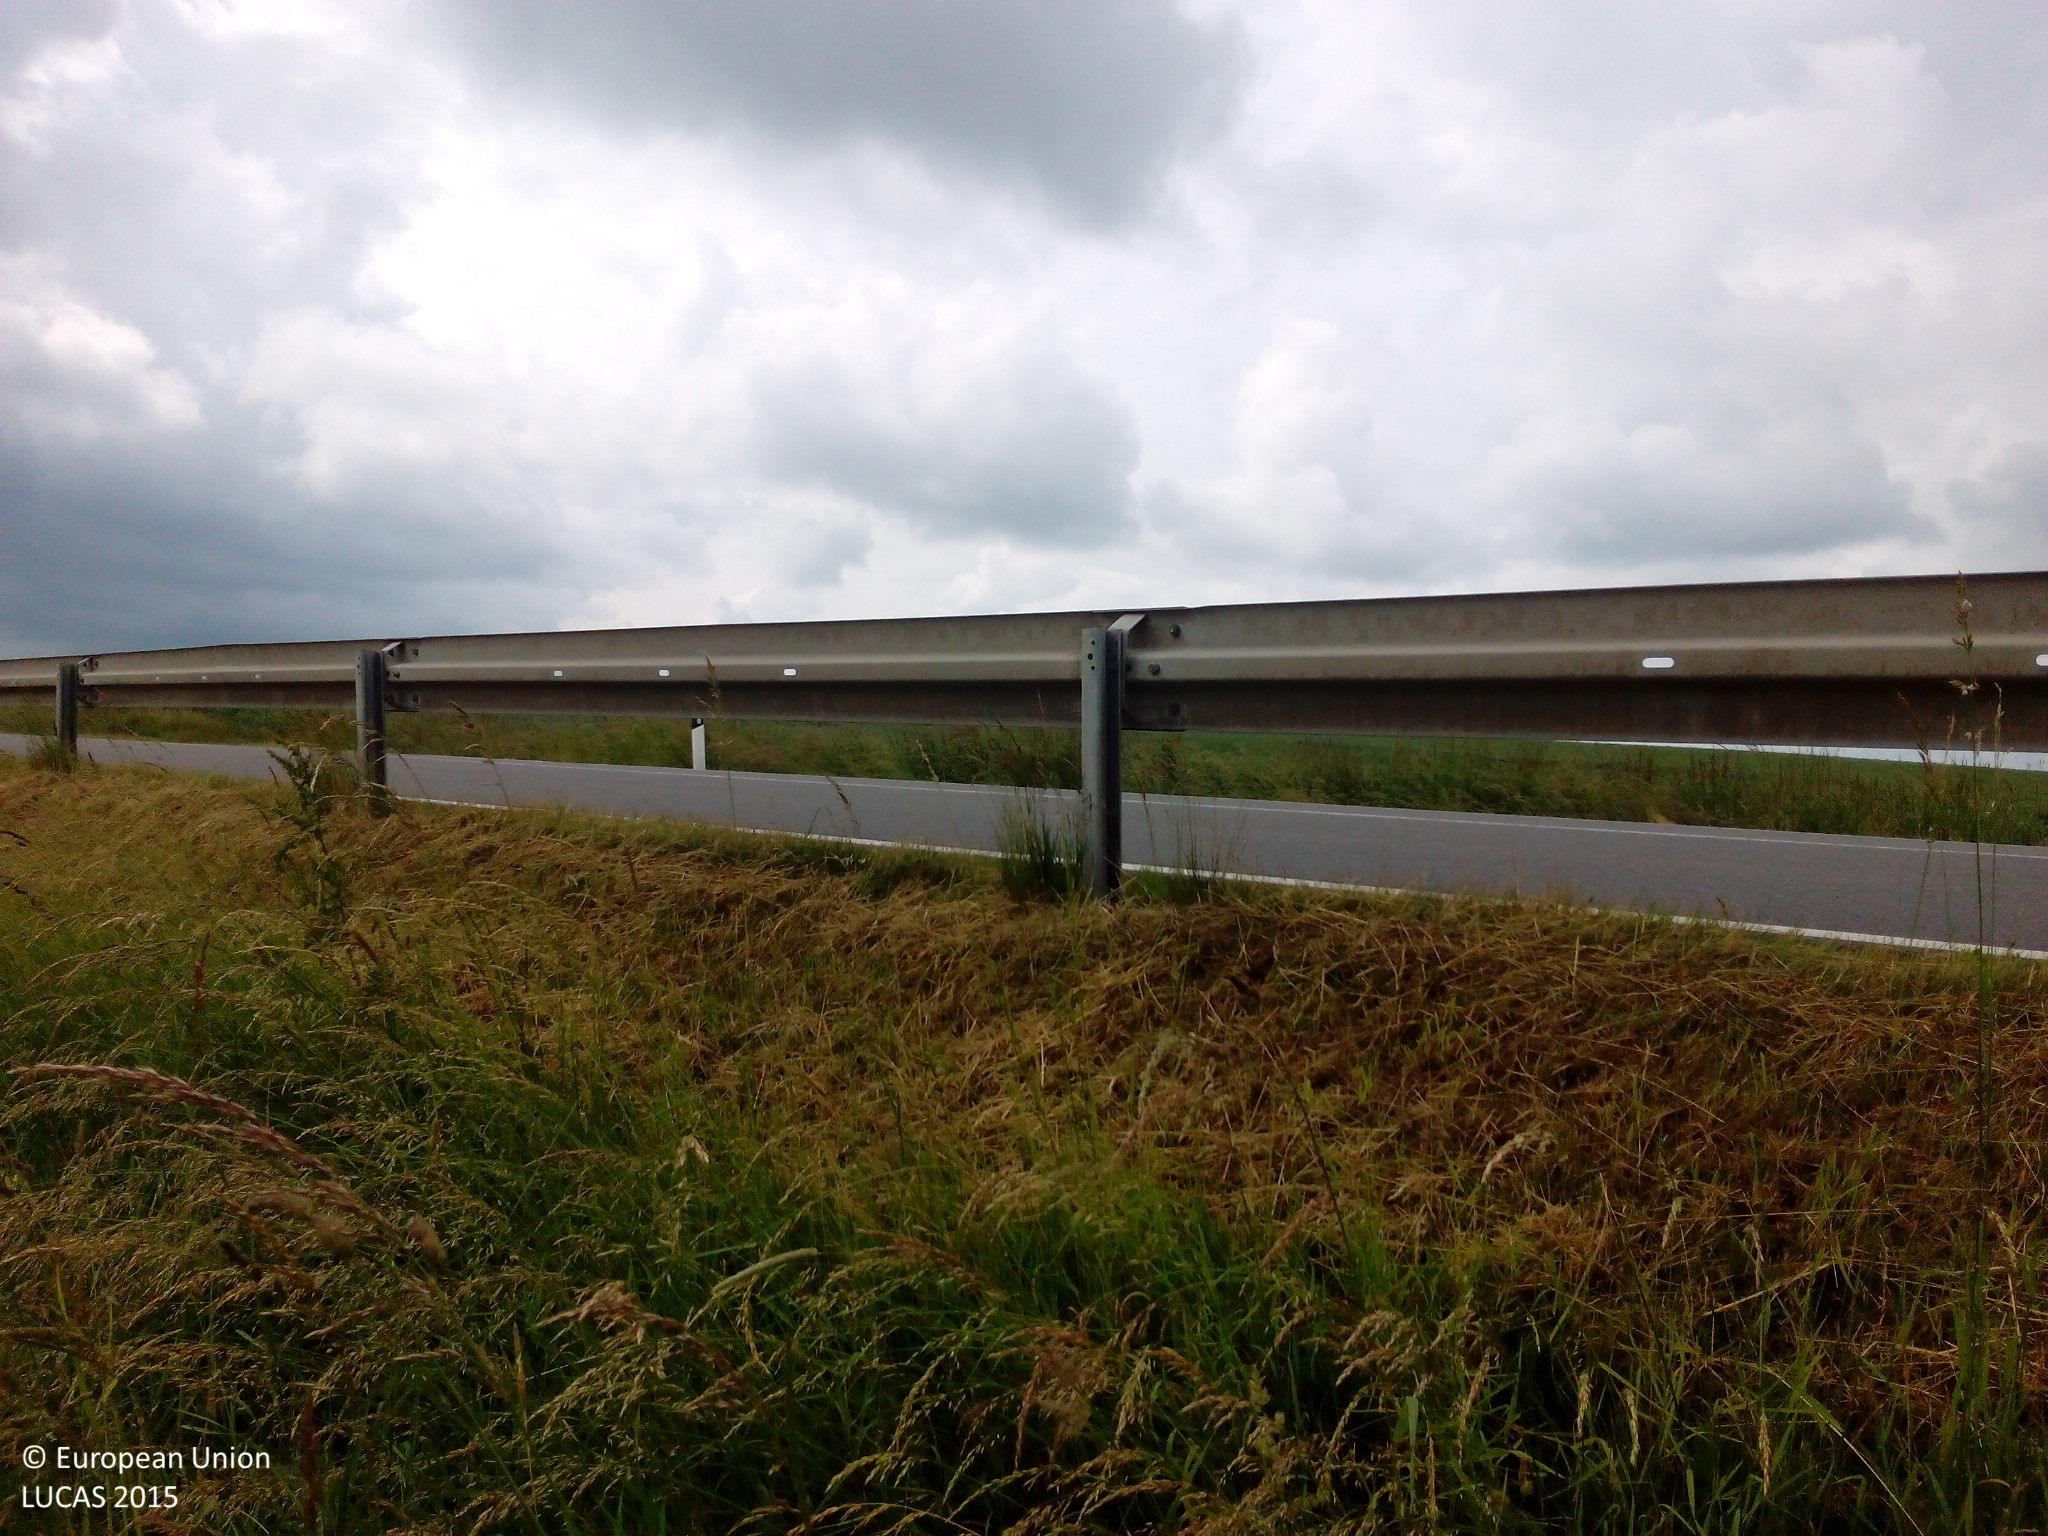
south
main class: Cropland
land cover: Common wheat
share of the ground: > 75 %
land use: Agriculture (excluding fallow land and kitchen gardens)
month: June
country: DE
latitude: 51.0419
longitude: 13.0951
